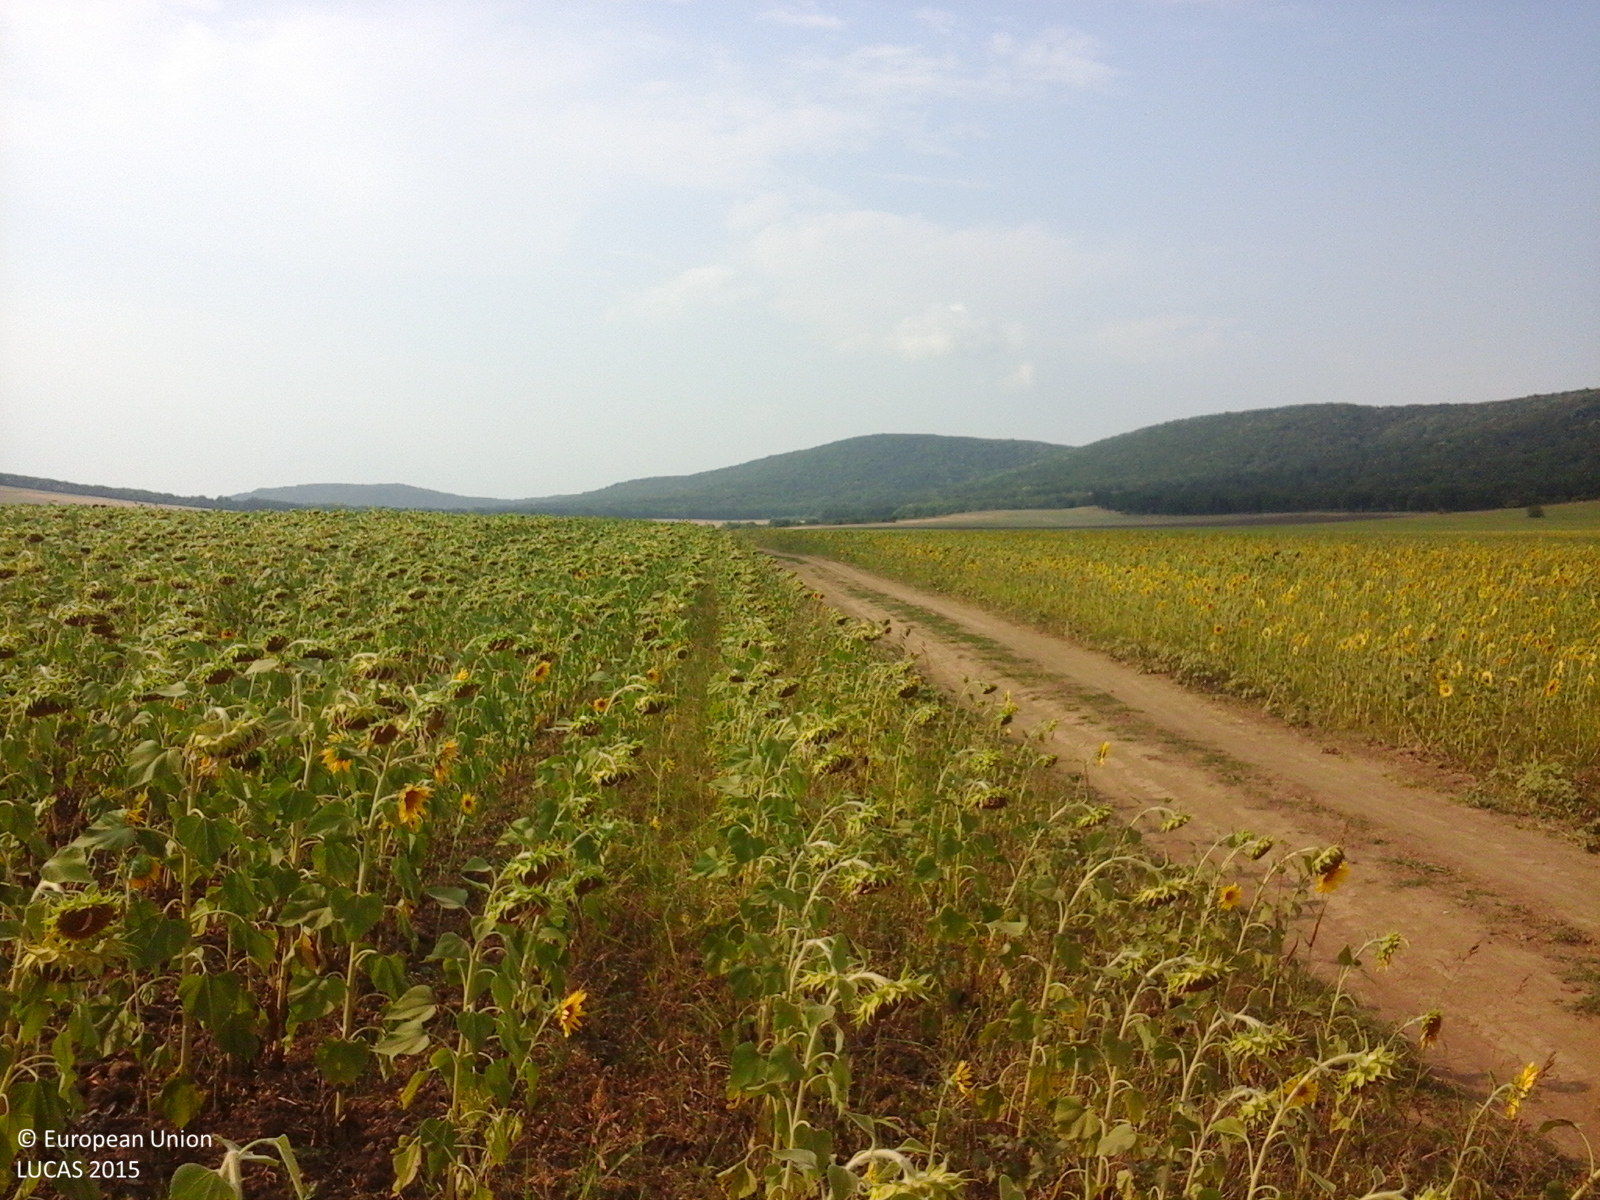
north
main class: Cropland
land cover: Sunflower
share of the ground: > 75 %
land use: Agriculture (excluding fallow land and kitchen gardens)
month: July
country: RO
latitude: 45.0990
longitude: 28.4398
